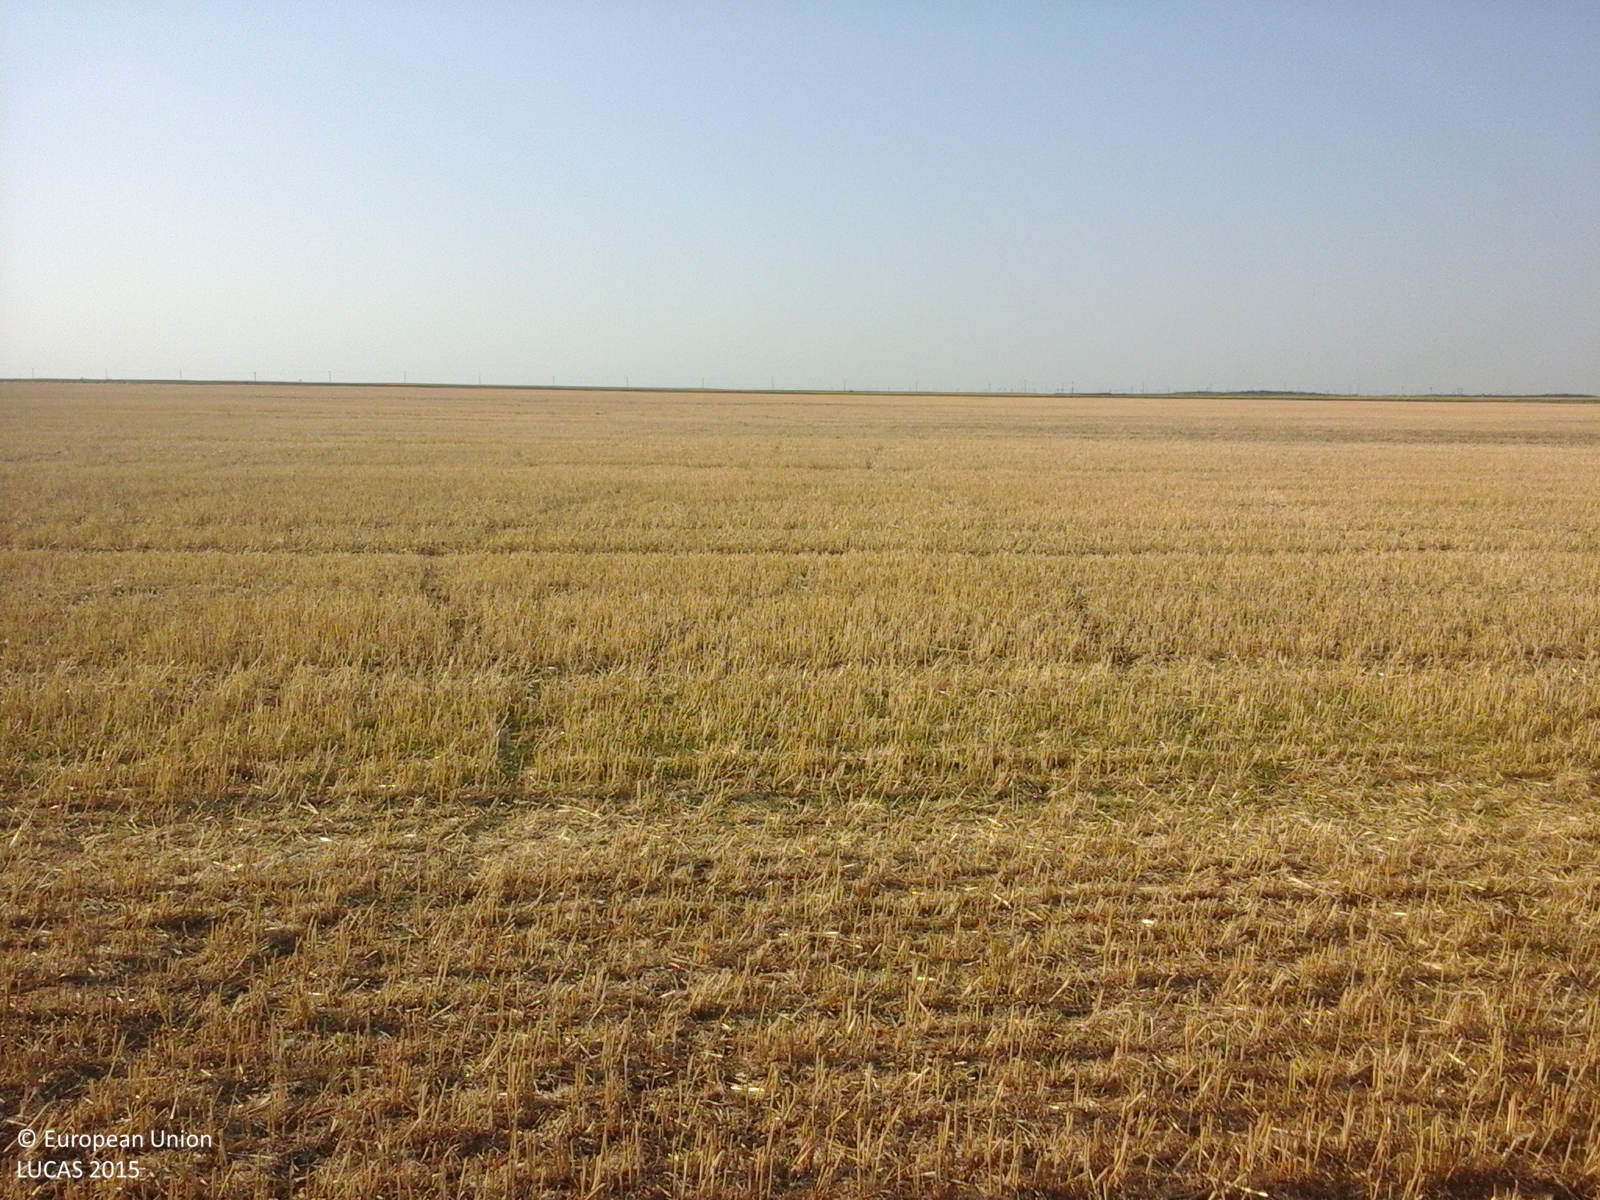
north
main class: Cropland
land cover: Common wheat
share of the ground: < 10 %
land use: Agriculture (excluding fallow land and kitchen gardens)
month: July
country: RO
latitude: 44.9960
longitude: 27.3316
